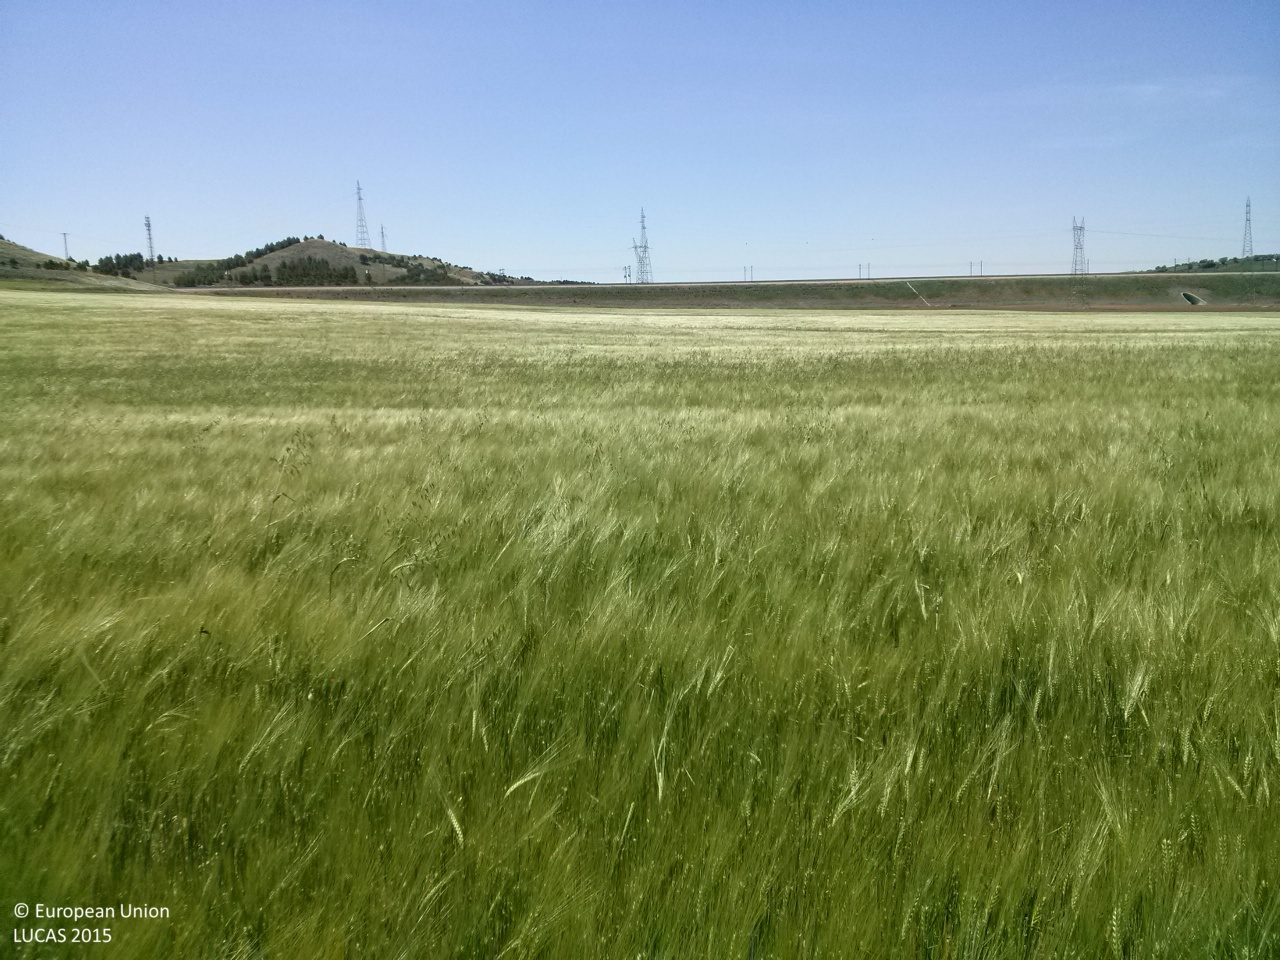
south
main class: Cropland
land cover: Barley
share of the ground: > 75 %
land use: Agriculture (excluding fallow land and kitchen gardens)
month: May
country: ES
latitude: 40.0219
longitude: -2.8524
